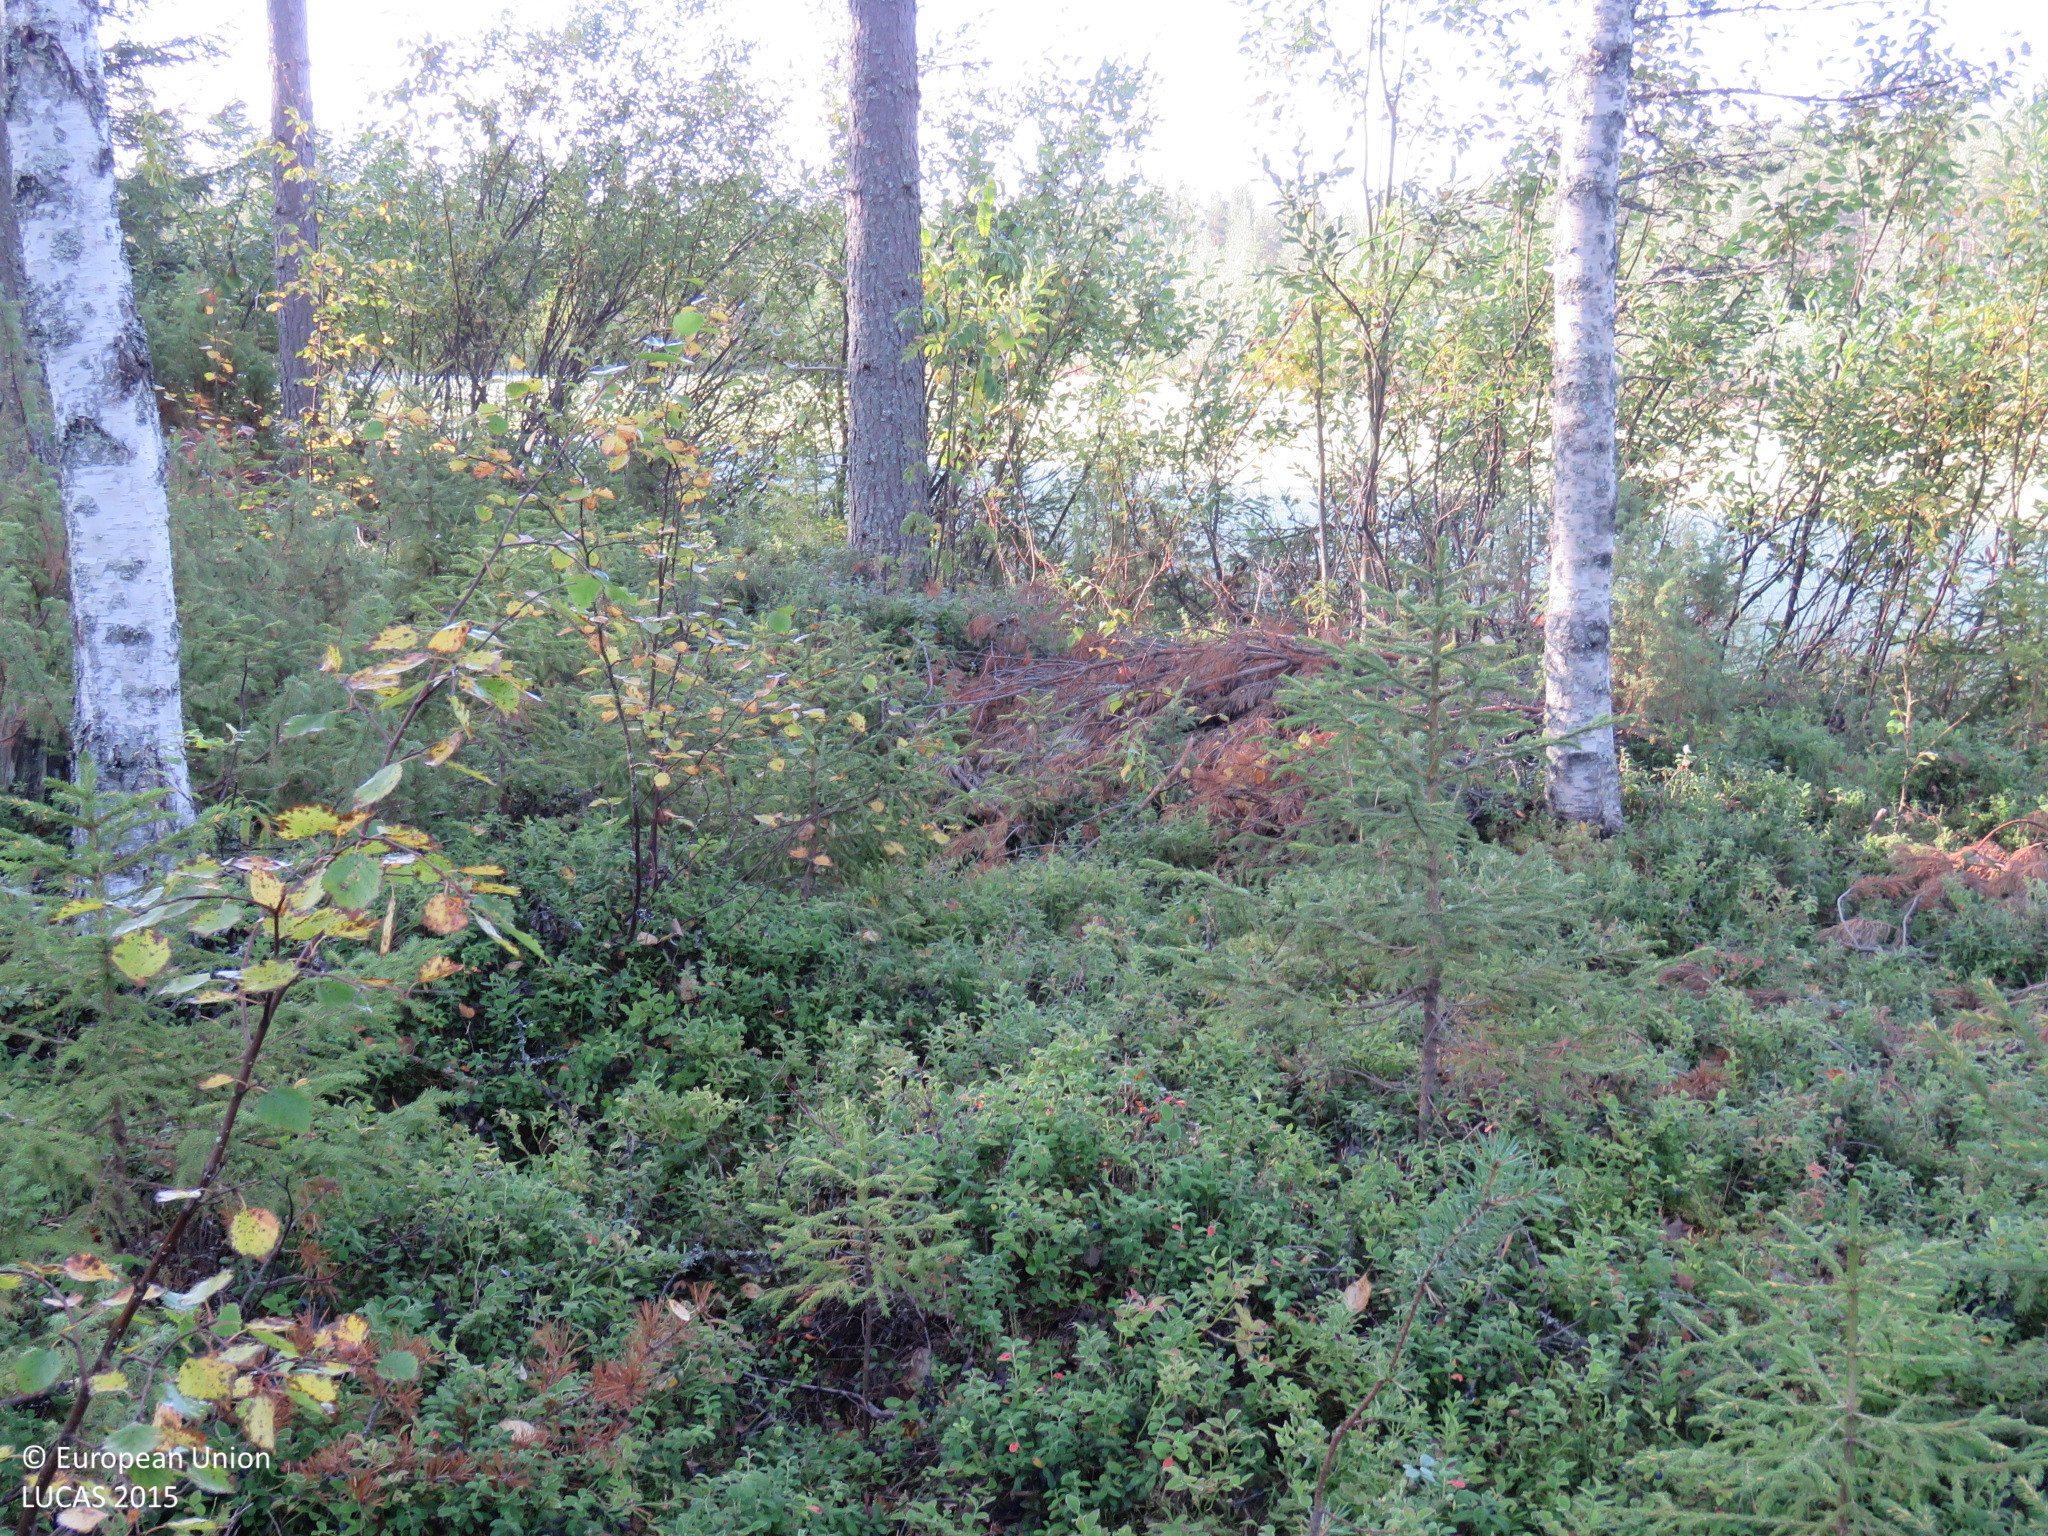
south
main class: Woodland
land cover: Pine dominated mixed woodland
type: boreal forest
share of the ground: > 75 %
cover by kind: coniferous forest trees 45 %, broadleaved forest trees 35 %, shrubs 20 %
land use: Forestry
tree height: > 5 m
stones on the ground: < 10 %
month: September
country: FI
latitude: 65.4745
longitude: 27.5546
